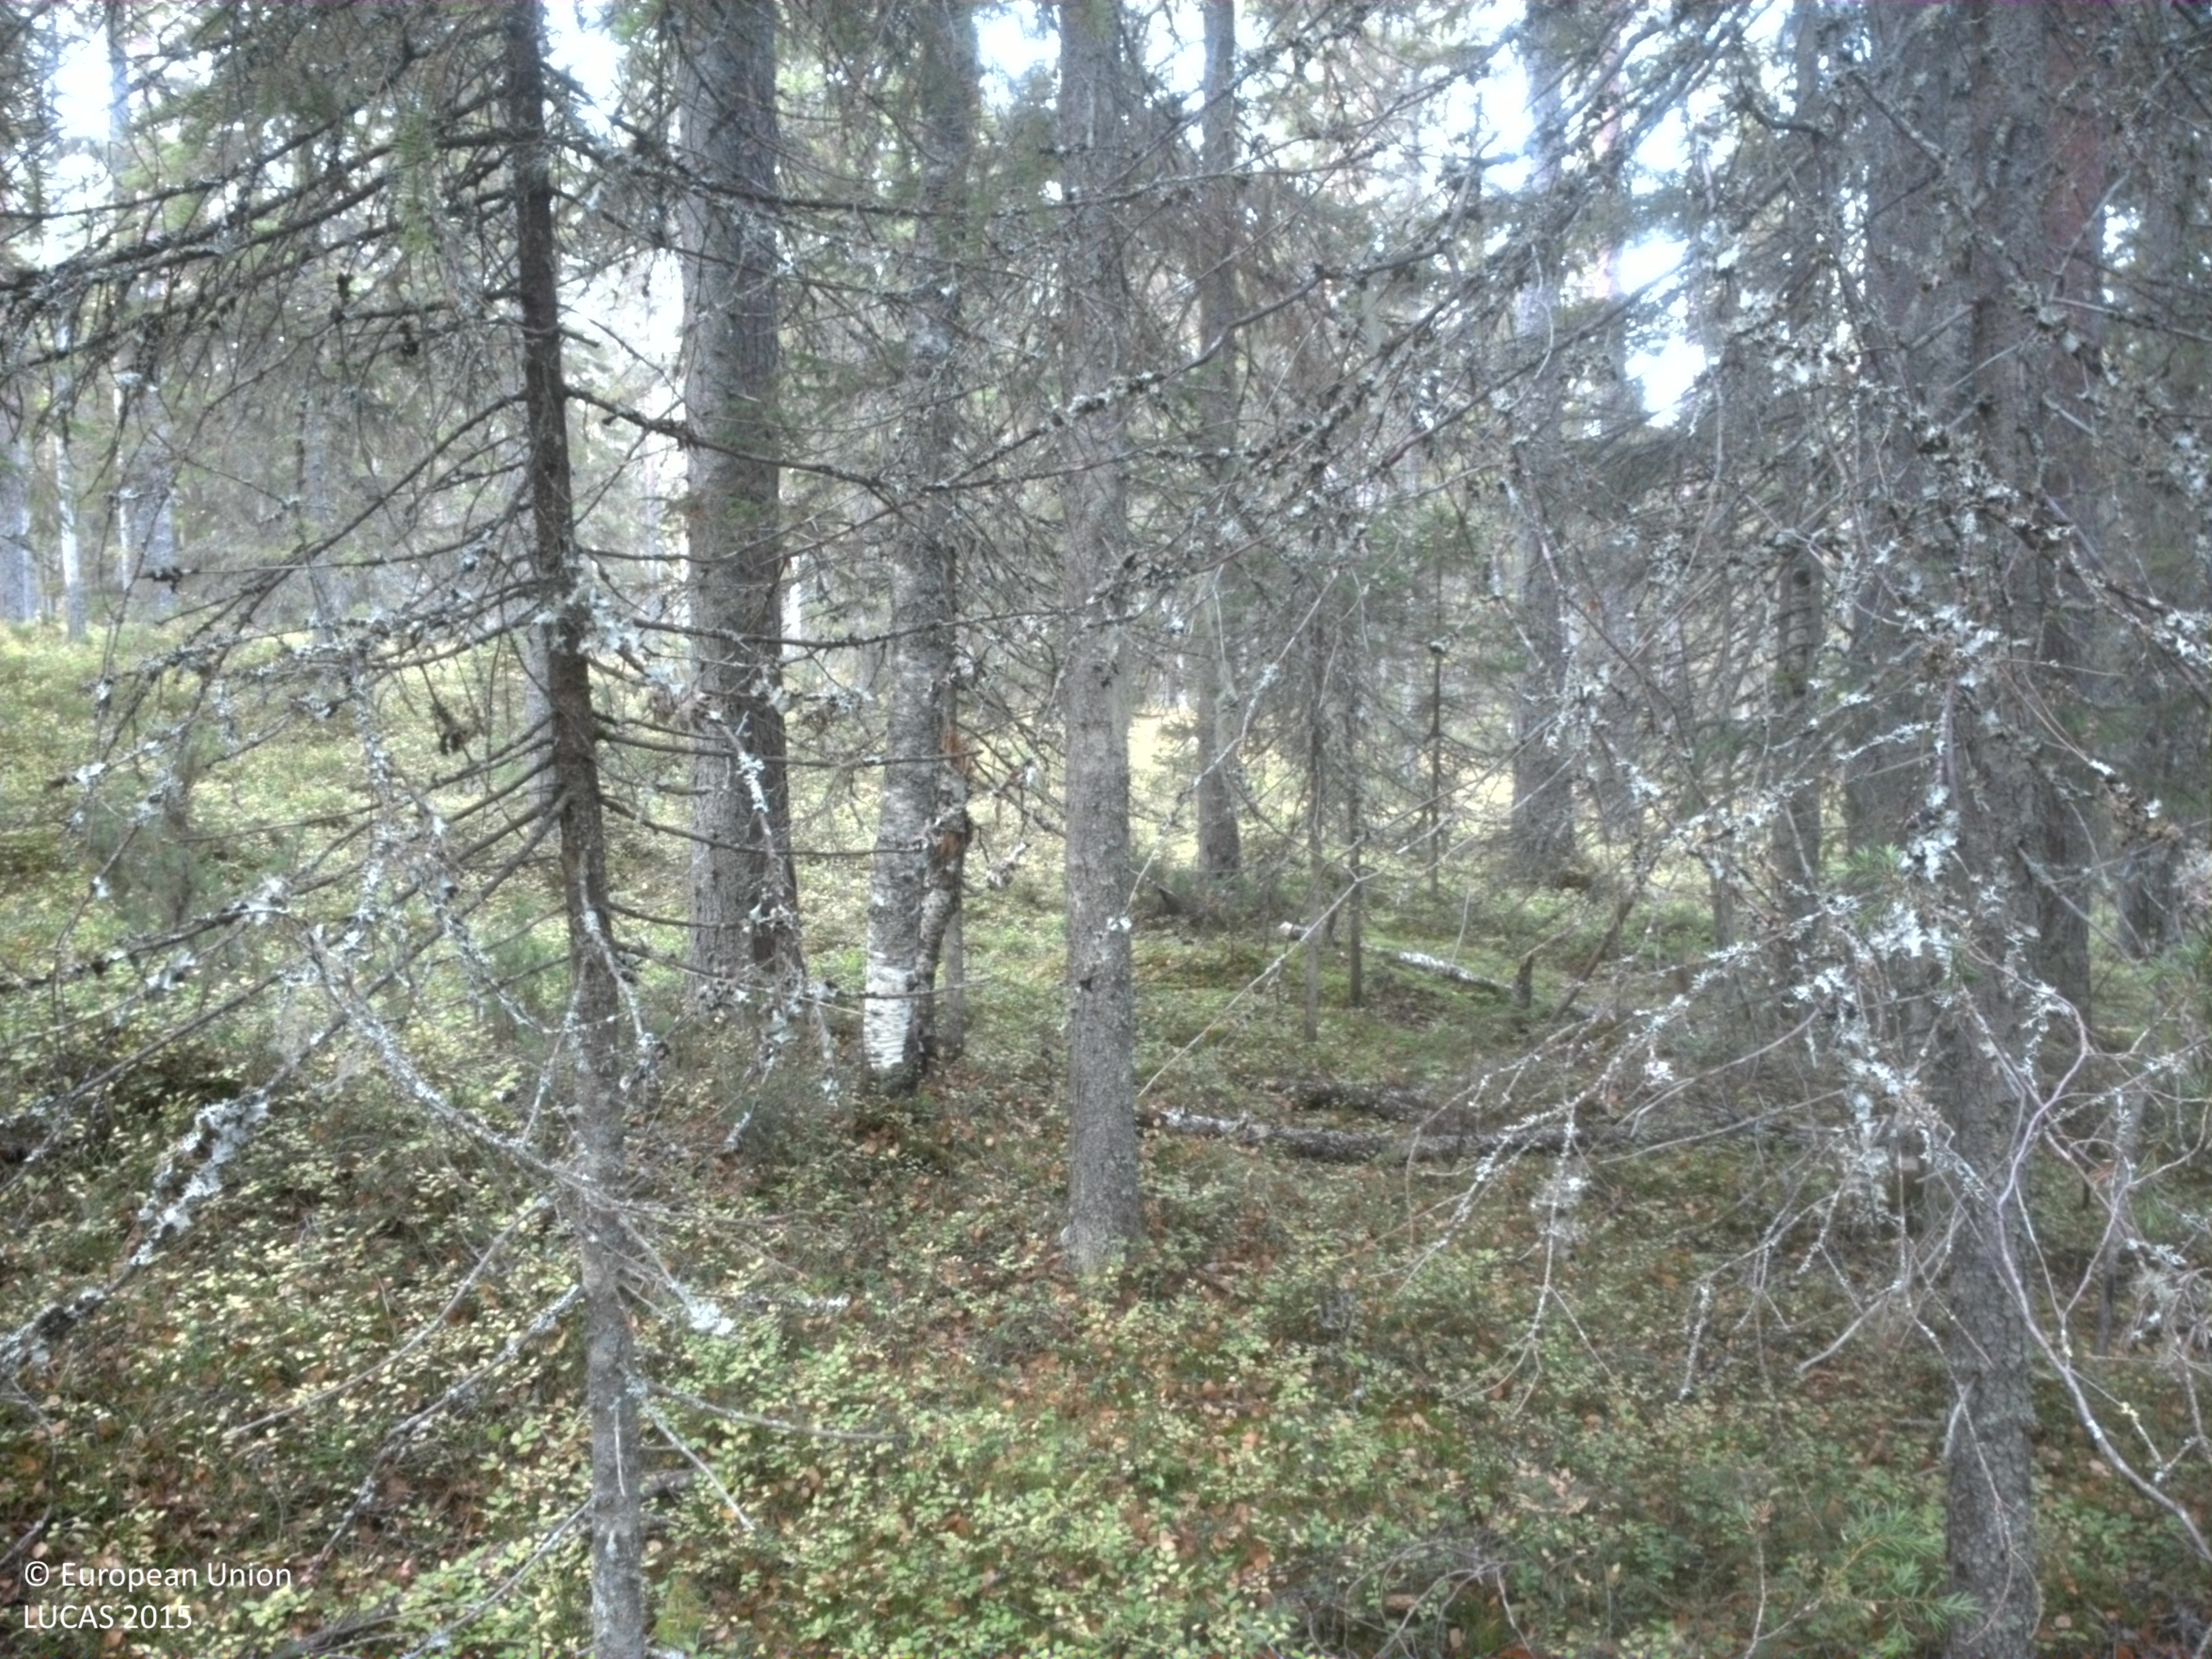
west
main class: Woodland
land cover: Spruce dominated coniferous woodland
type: boreal forest
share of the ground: 50 - 75 %
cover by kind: coniferous forest trees 60 %, shrubs 30 %, broadleaved forest trees 5 %, lichens and mosses 5 %
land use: Forestry
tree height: > 5 m
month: October
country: SE
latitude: 64.0433
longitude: 20.0329
